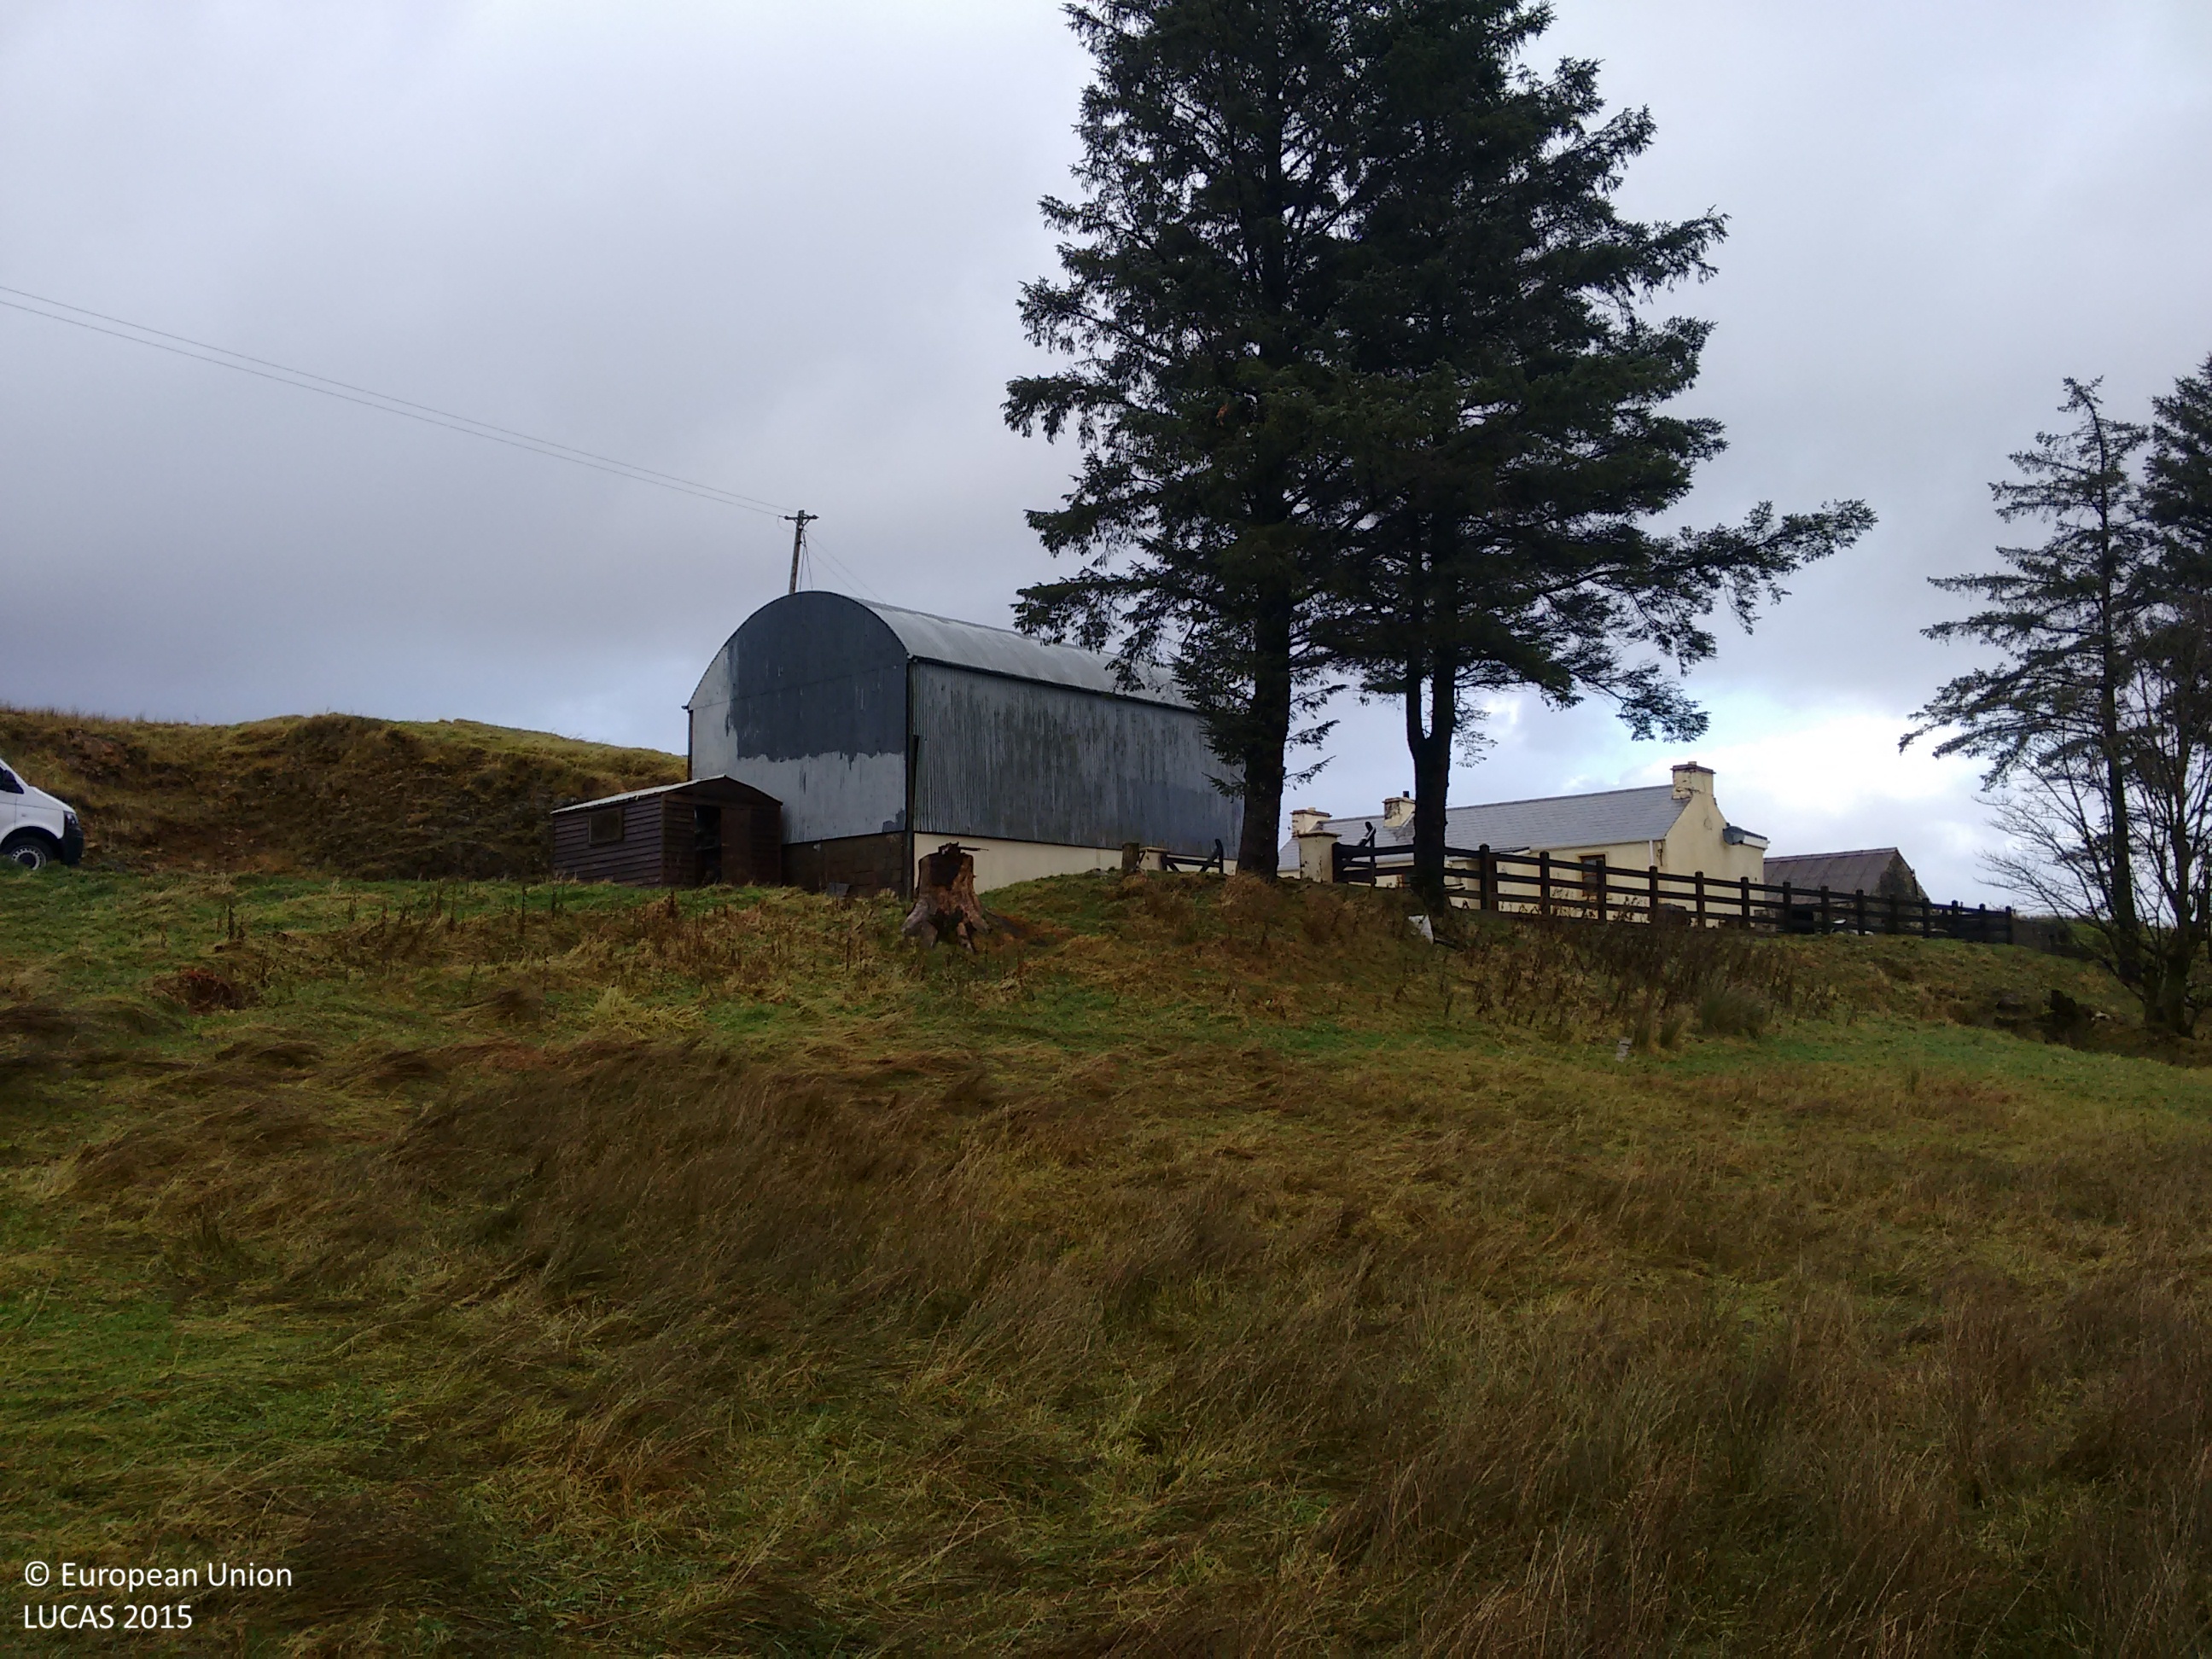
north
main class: Grassland
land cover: Grassland without tree/shrub cover
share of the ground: > 75 %
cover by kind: herbaceous plants 100 %
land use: Agriculture (excluding fallow land and kitchen gardens)
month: November
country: IE
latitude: 54.7238
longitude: -8.3025
